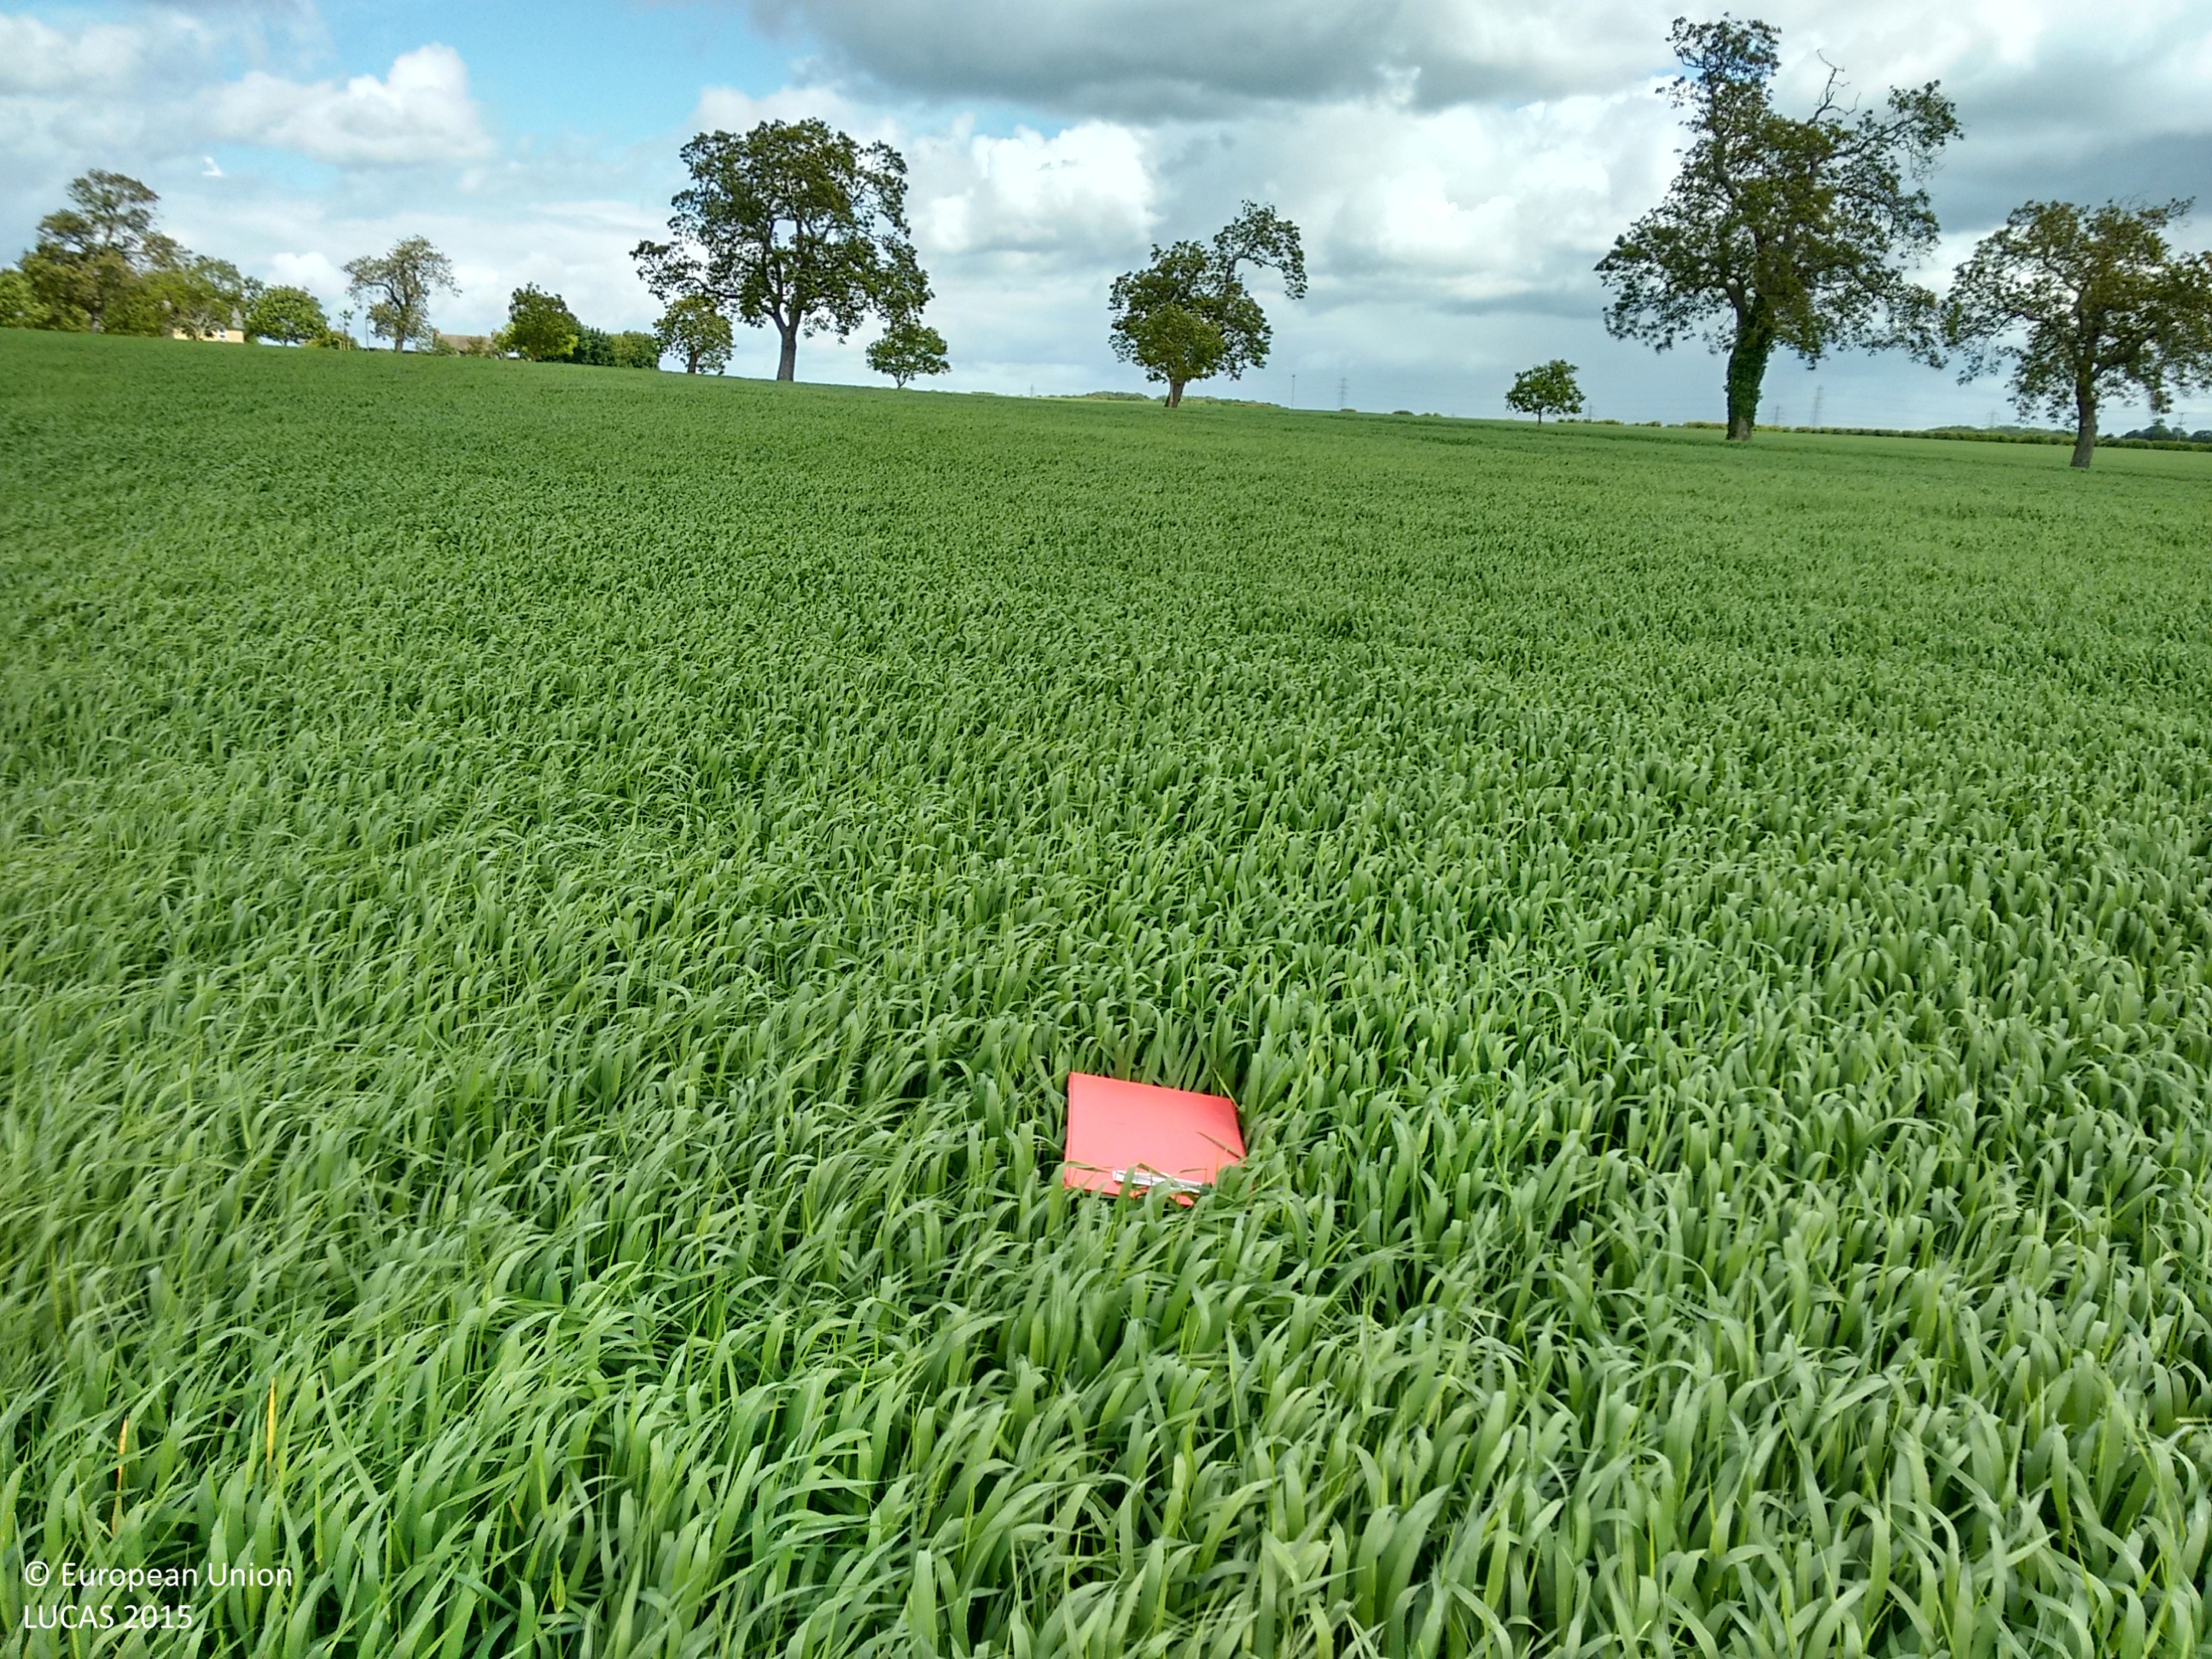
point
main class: Cropland
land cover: Barley
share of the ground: > 75 %
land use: Agriculture (excluding fallow land and kitchen gardens)
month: June
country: GB
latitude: 52.2338
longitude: -0.3298
